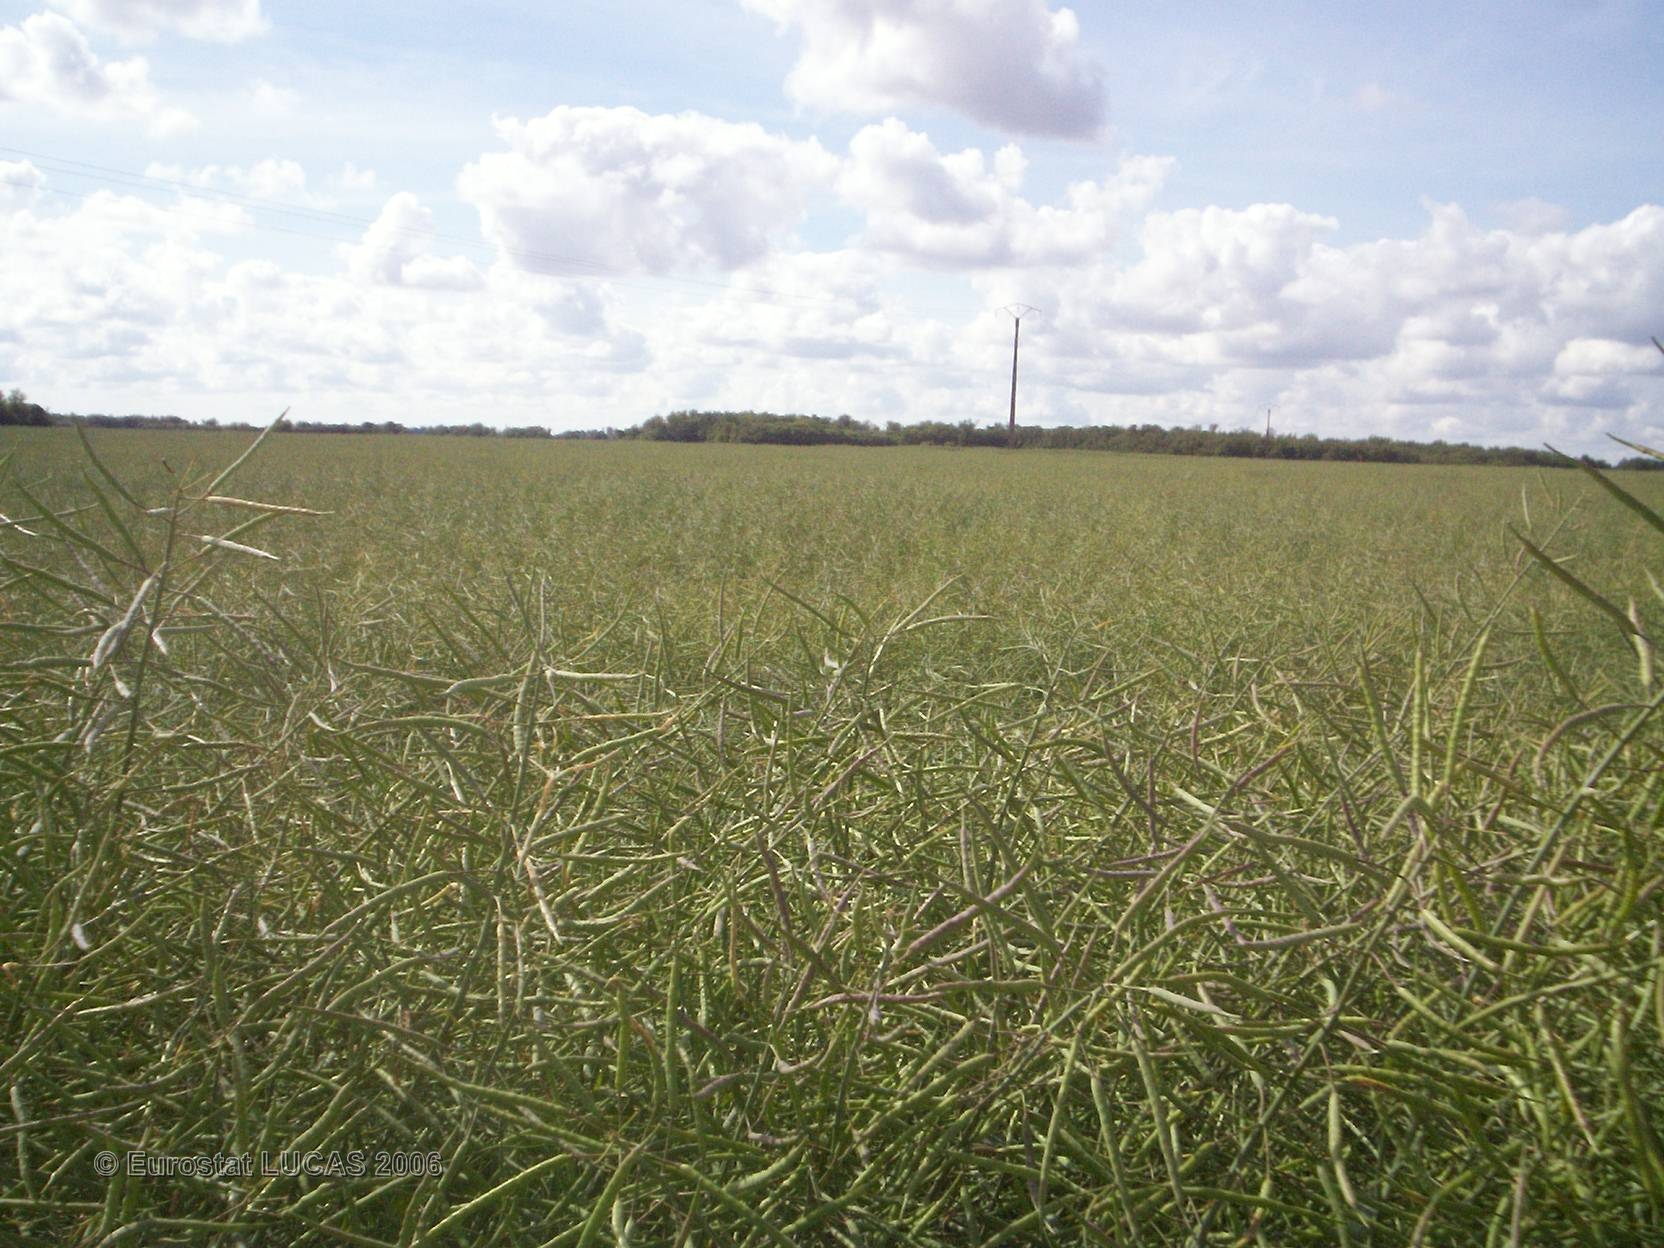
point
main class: Cropland
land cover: Rape and turnip rape
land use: Agriculture (excluding fallow land and kitchen gardens)
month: May
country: FR
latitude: 45.6607
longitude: -0.7673
